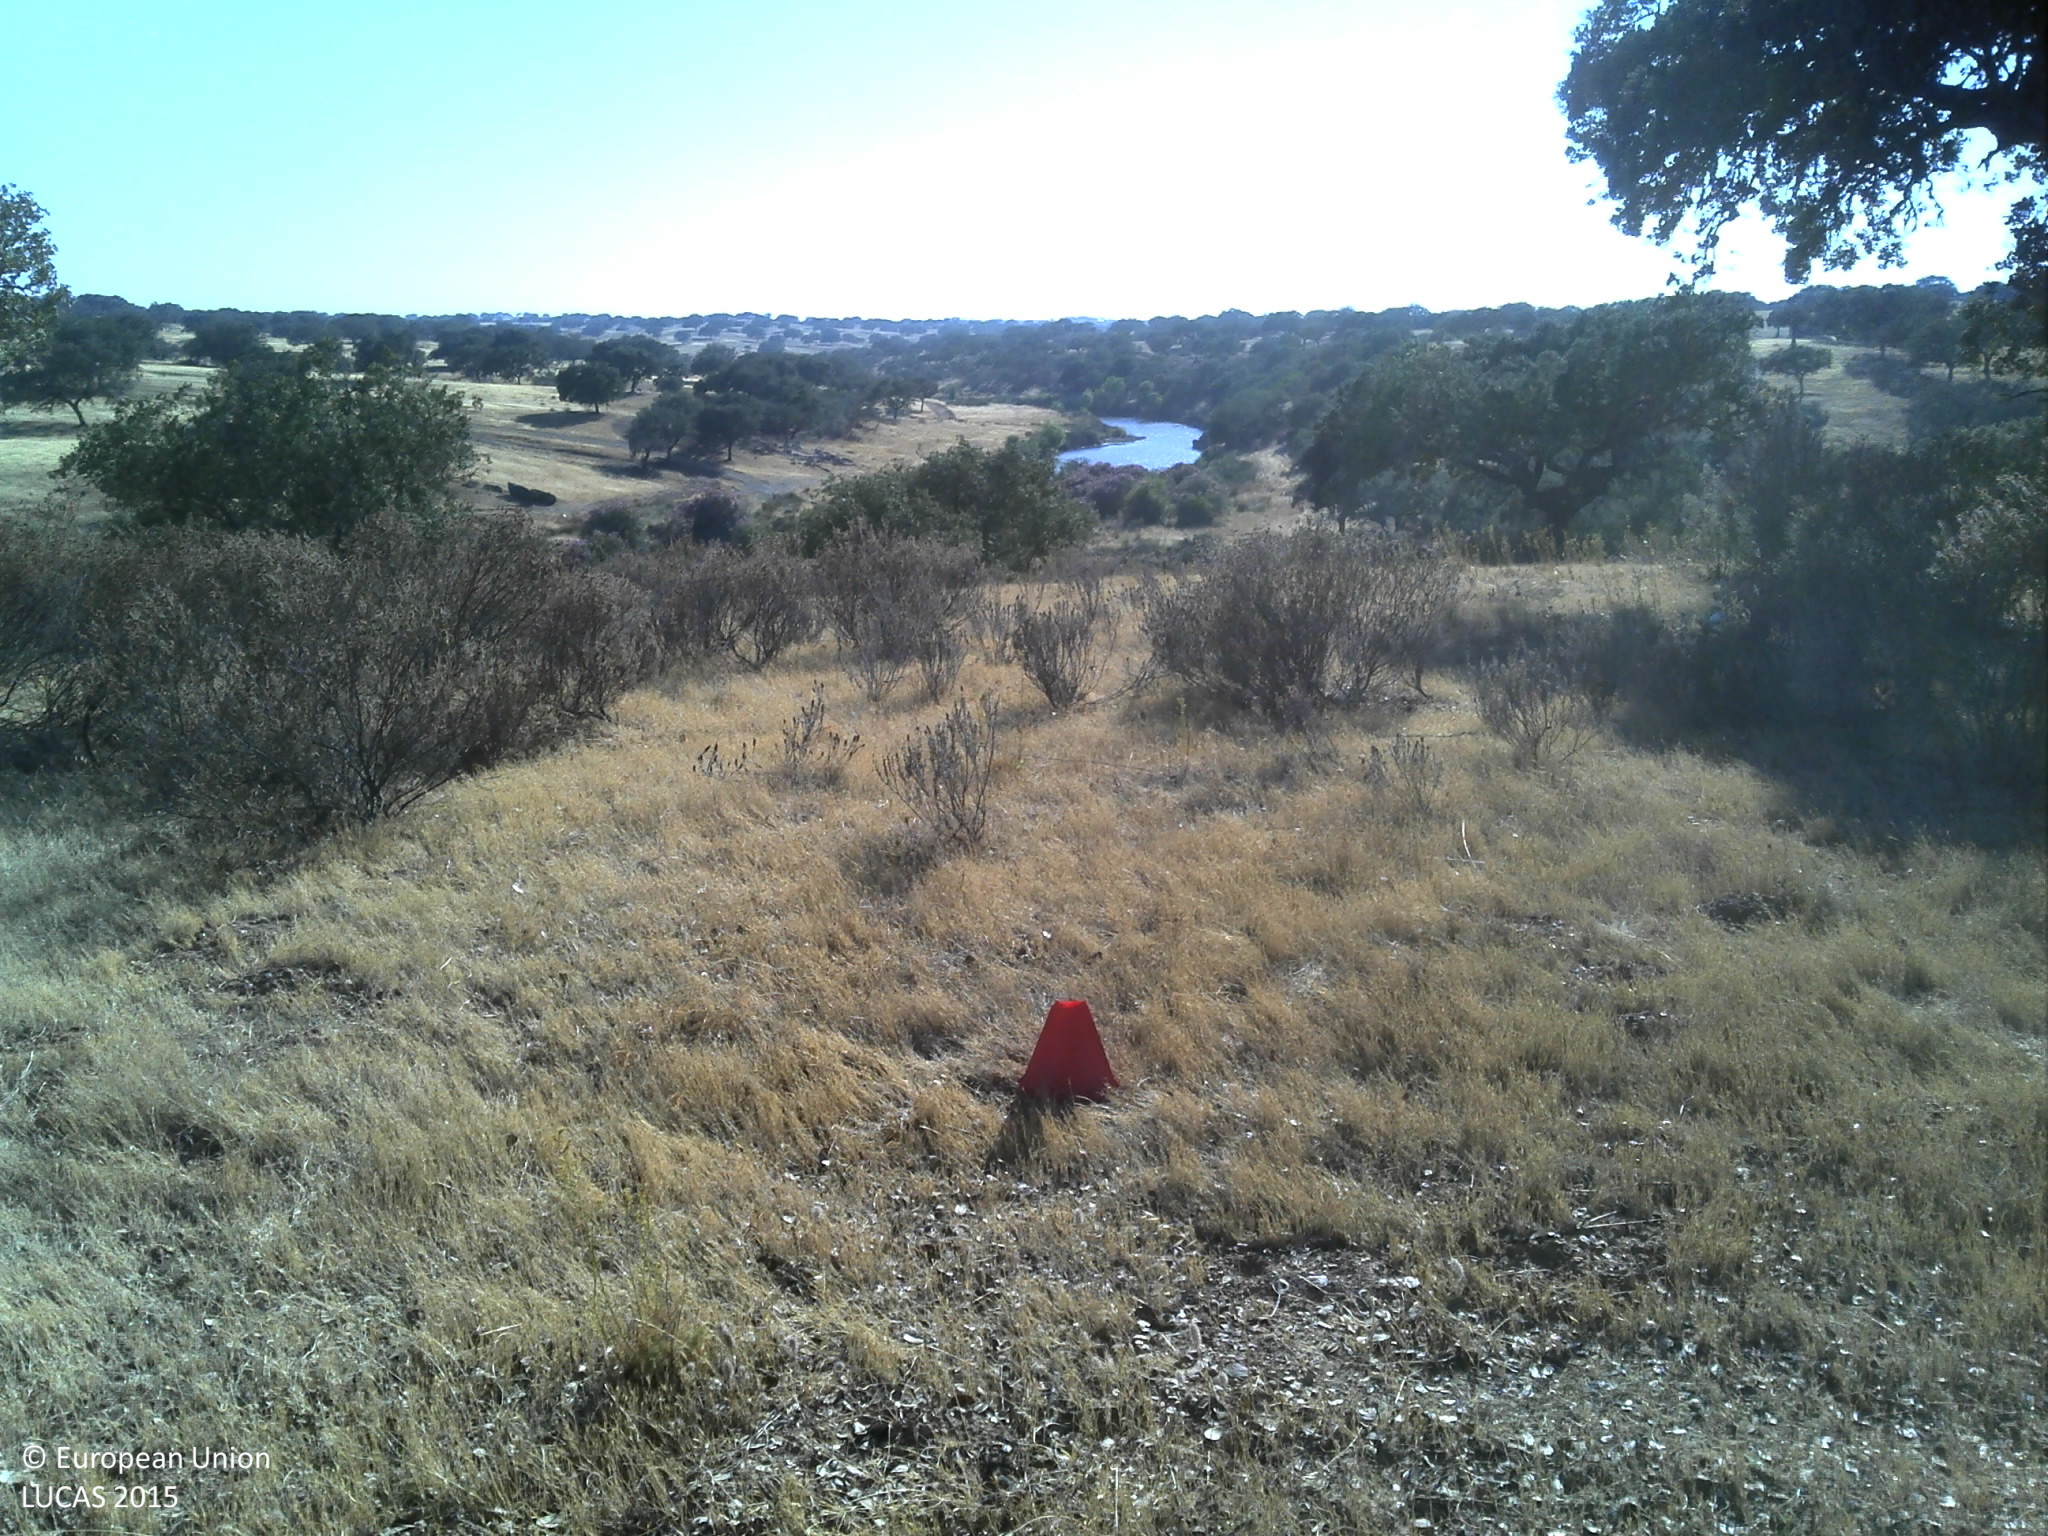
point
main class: Woodland
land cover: Broadleaved woodland
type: broadleaved evergreen forest
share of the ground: 25 - 50 %
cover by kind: broadleaved forest trees 50 %, herbaceous plants 25 %, unconsolidated bare surface 25 %
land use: Forestry
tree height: > 5 m
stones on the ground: < 10 %
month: July
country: PT
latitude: 37.8609
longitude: -7.9284
